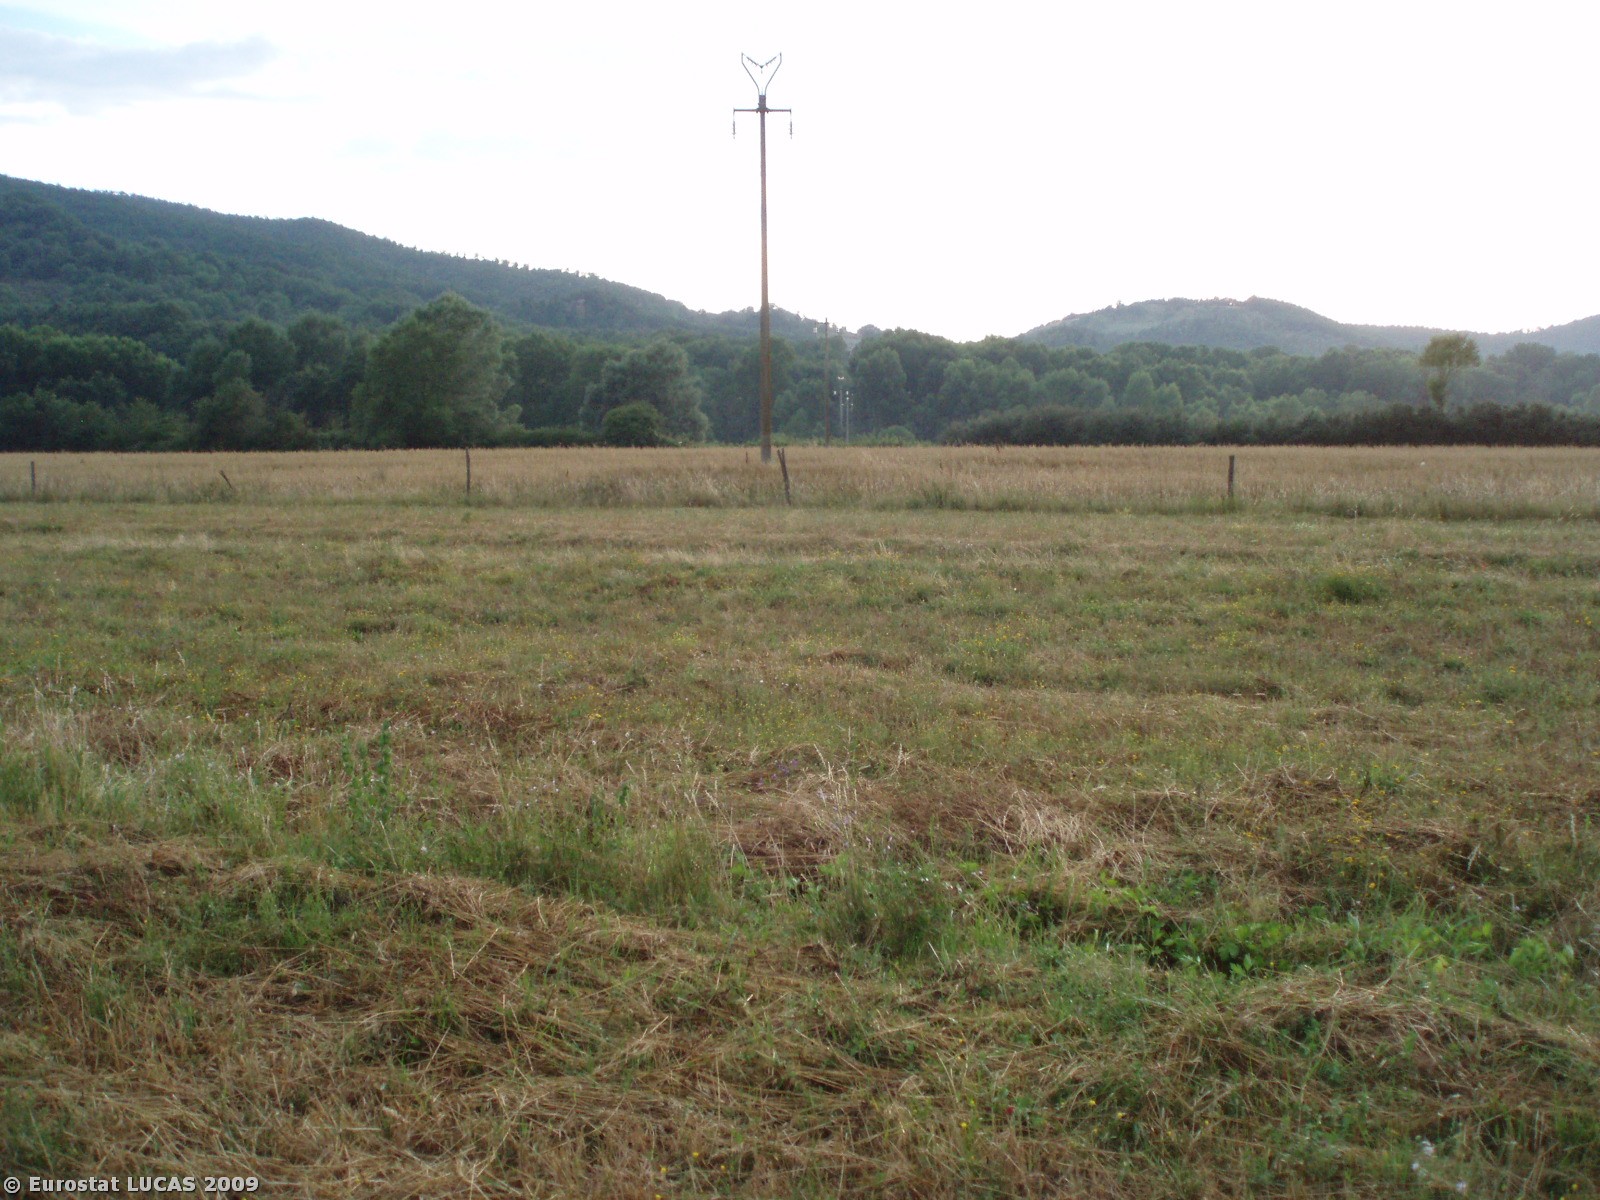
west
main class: Grassland
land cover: Grassland without tree/shrub cover
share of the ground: > 75 %
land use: Agriculture (excluding fallow land and kitchen gardens)
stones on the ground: < 10 %
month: June
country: IT
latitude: 42.6054
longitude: 11.5914
